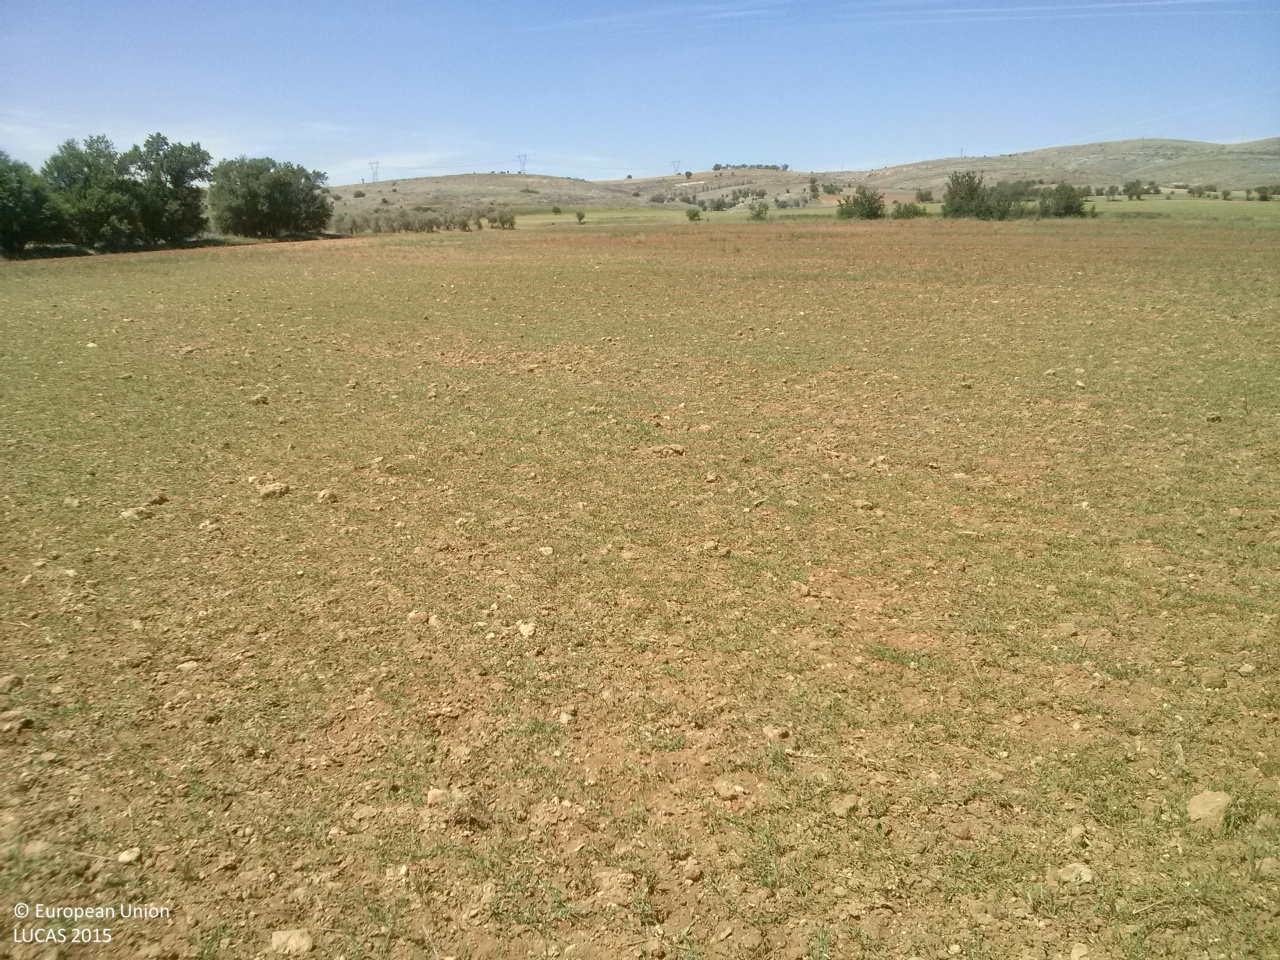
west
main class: Grassland
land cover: Spontaneously vegetated surfaces
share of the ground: 25 - 50 %
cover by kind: unconsolidated bare surface 60 %, herbaceous plants 40 %
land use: Fallow land
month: May
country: ES
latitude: 39.9389
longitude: -2.7883
